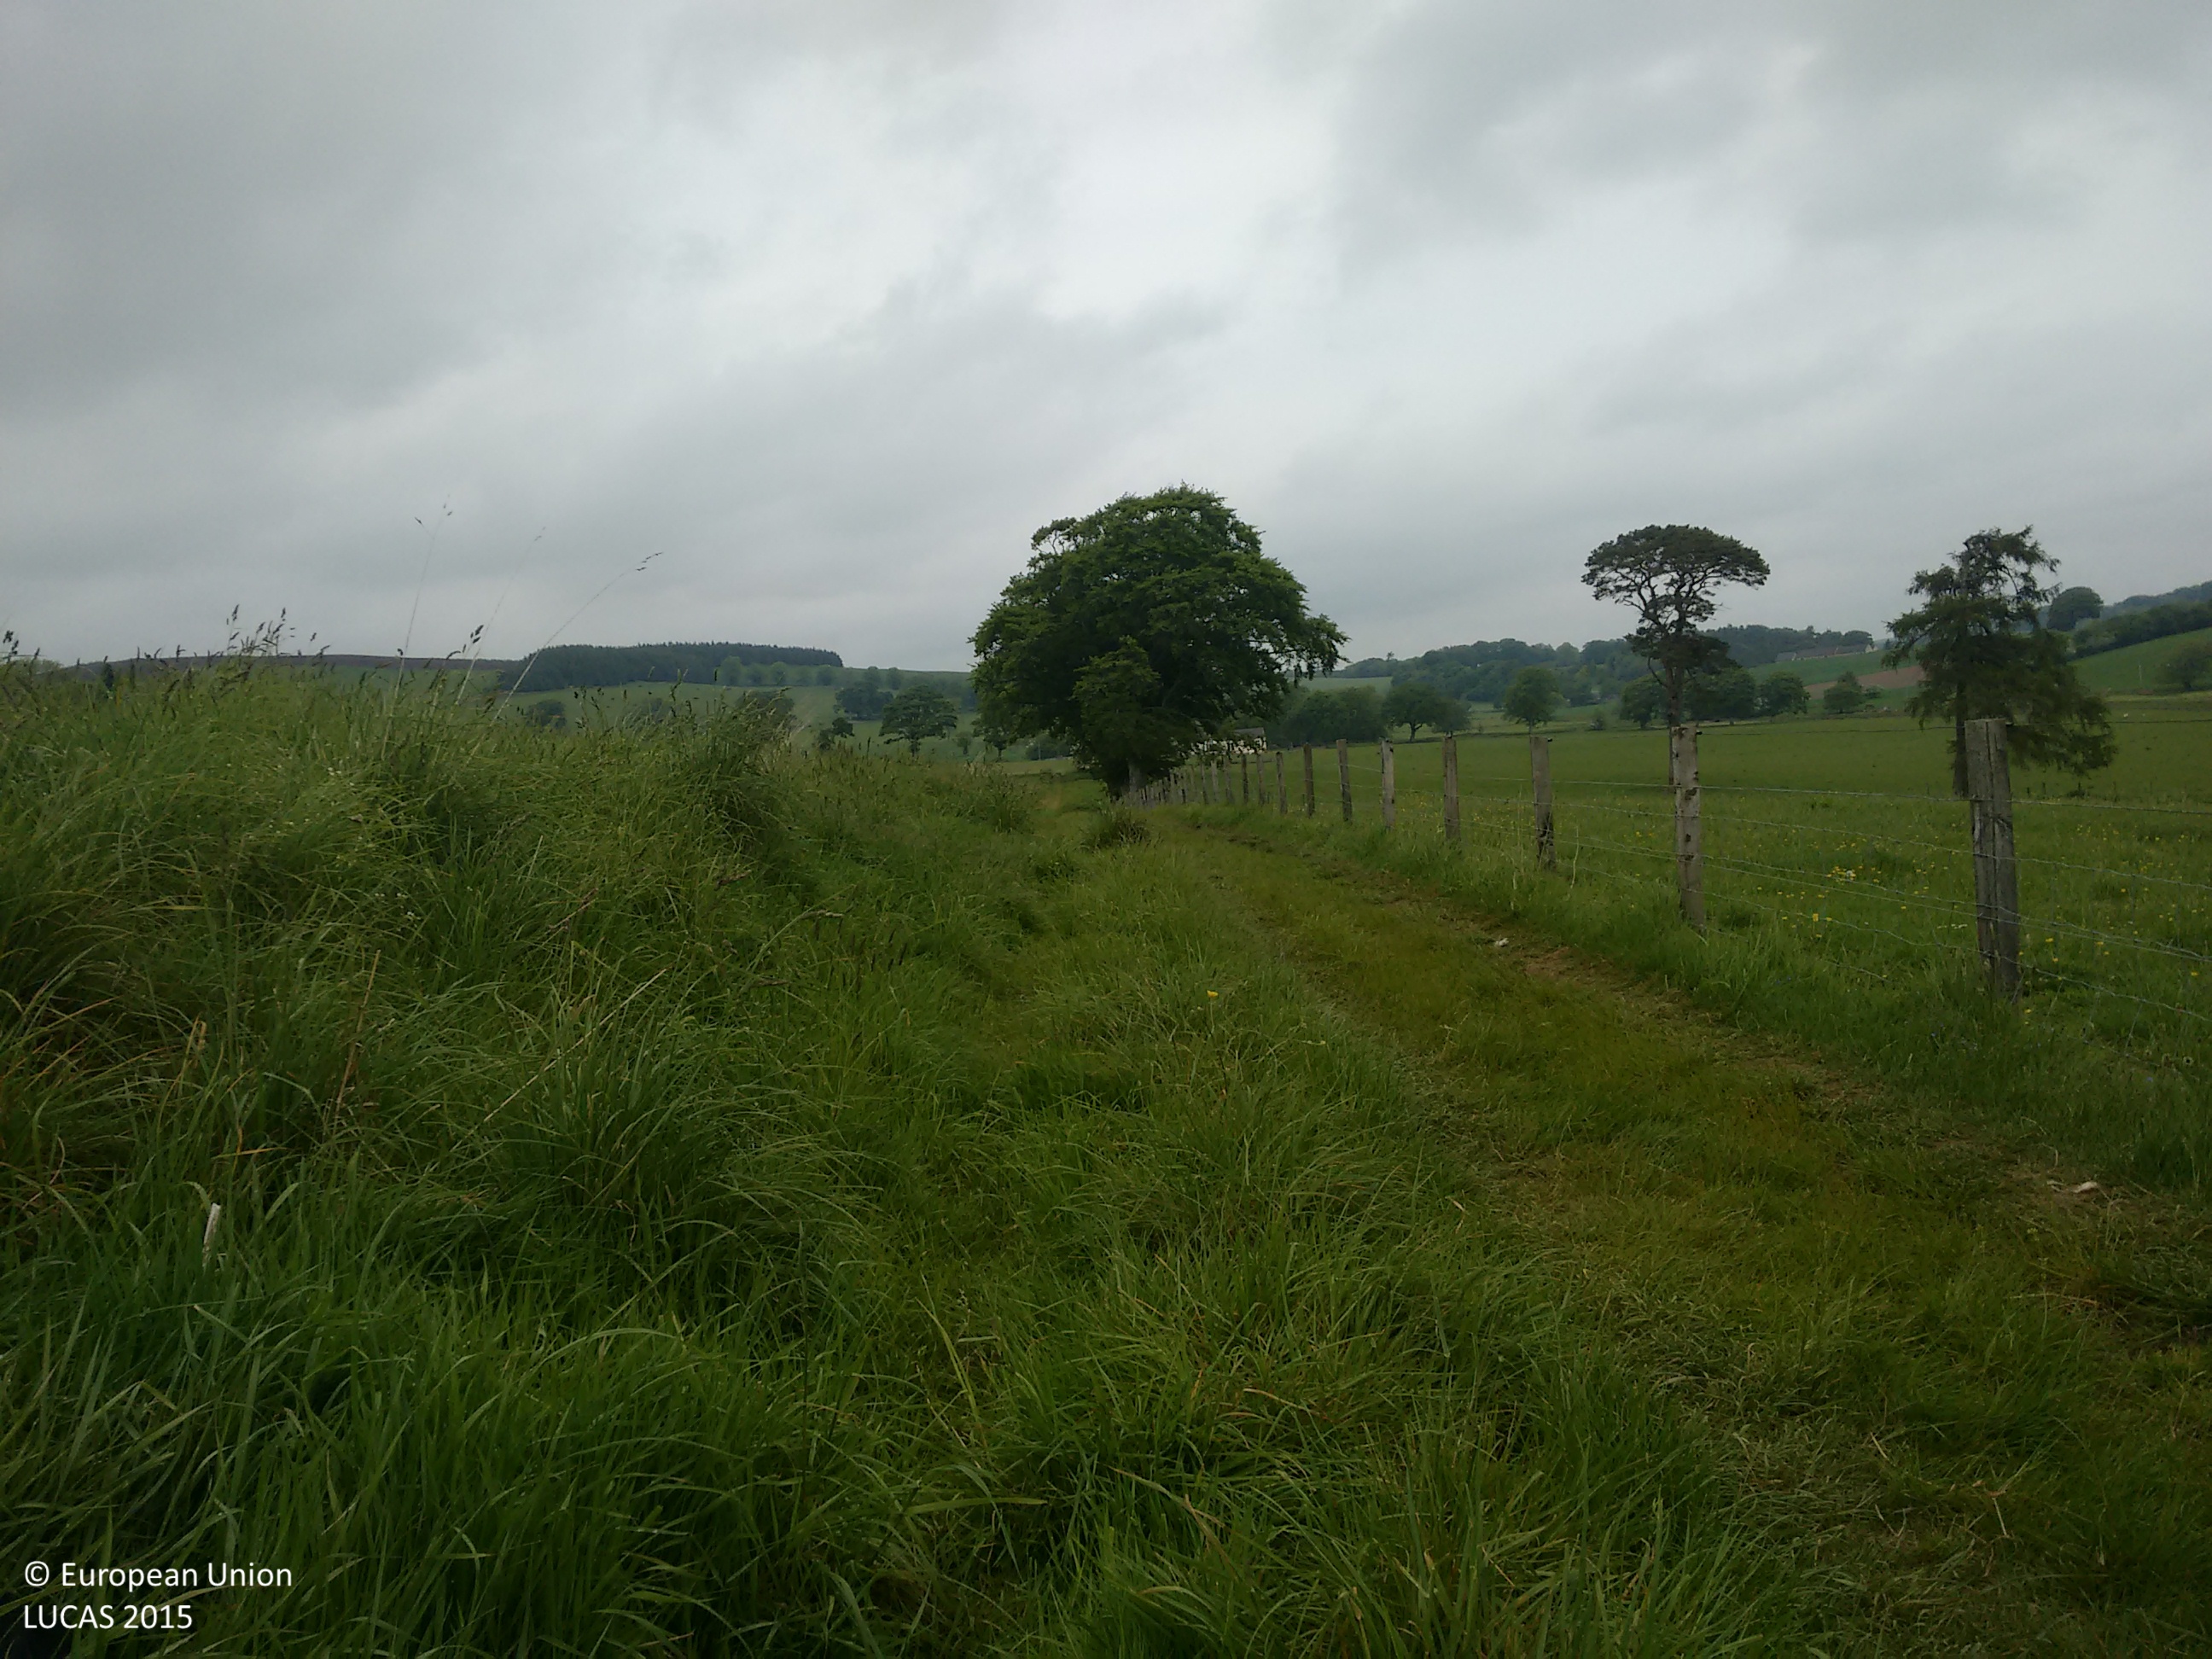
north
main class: Grassland
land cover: Grassland without tree/shrub cover
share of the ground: > 75 %
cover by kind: herbaceous plants 100 %
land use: Agriculture (excluding fallow land and kitchen gardens)
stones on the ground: < 10 %
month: June
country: GB
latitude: 55.6308
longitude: -3.5325
